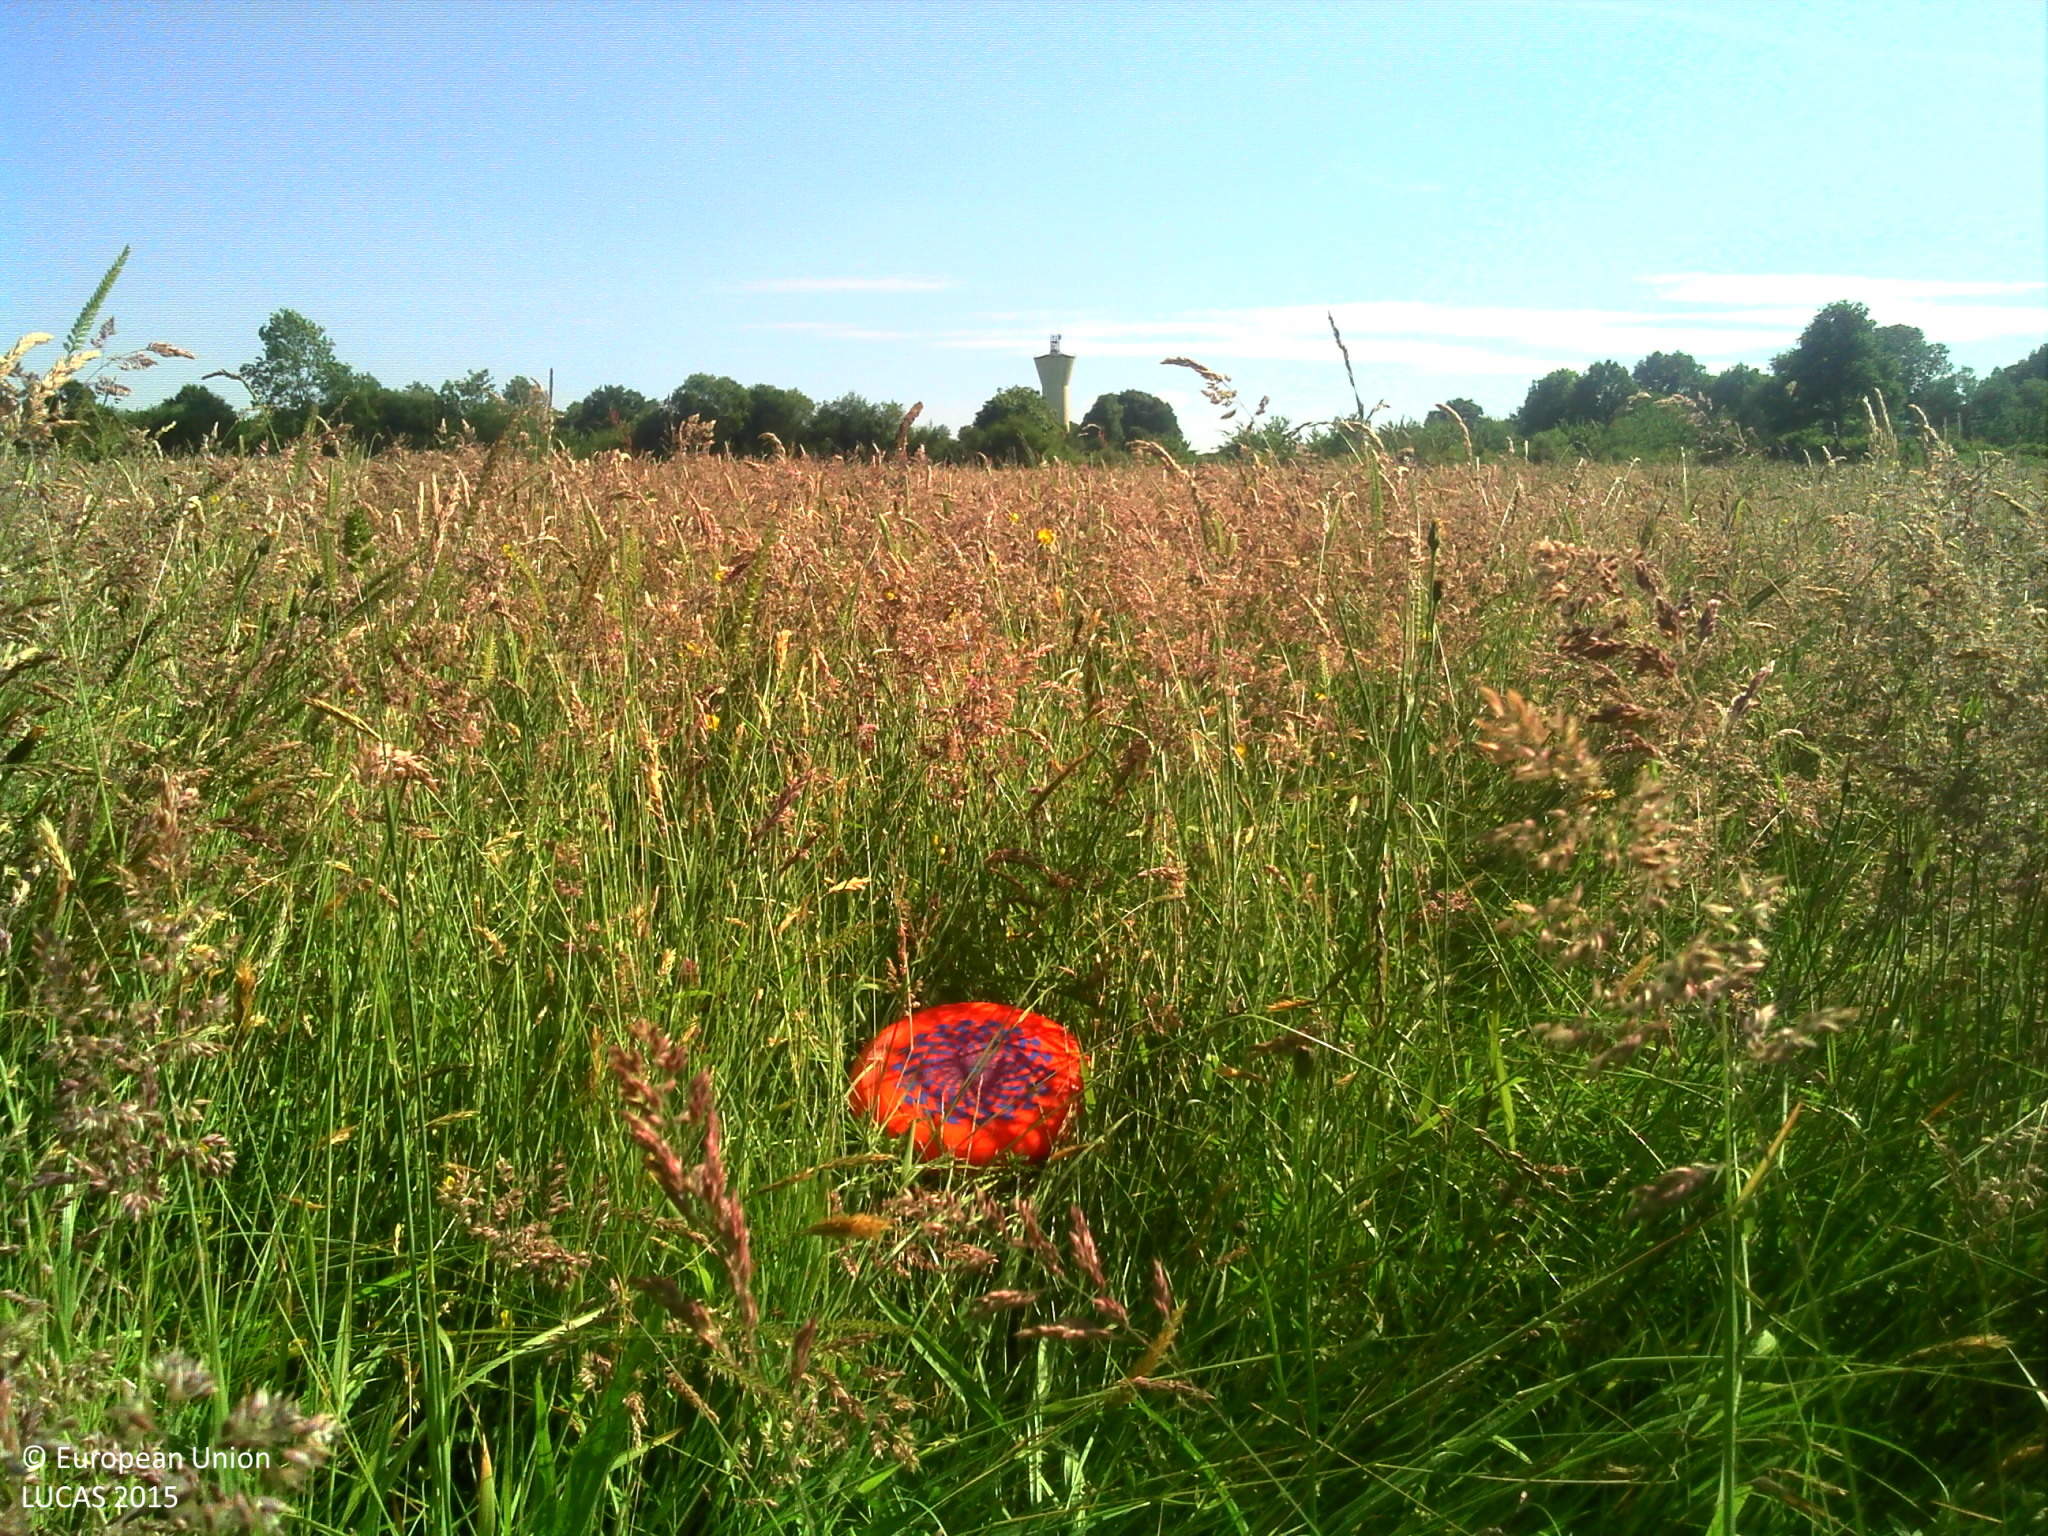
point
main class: Grassland
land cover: Grassland without tree/shrub cover
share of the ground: > 75 %
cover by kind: herbaceous plants 100 %
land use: Agriculture (excluding fallow land and kitchen gardens)
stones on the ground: < 10 %
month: June
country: FR
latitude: 48.5921
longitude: -0.1047
